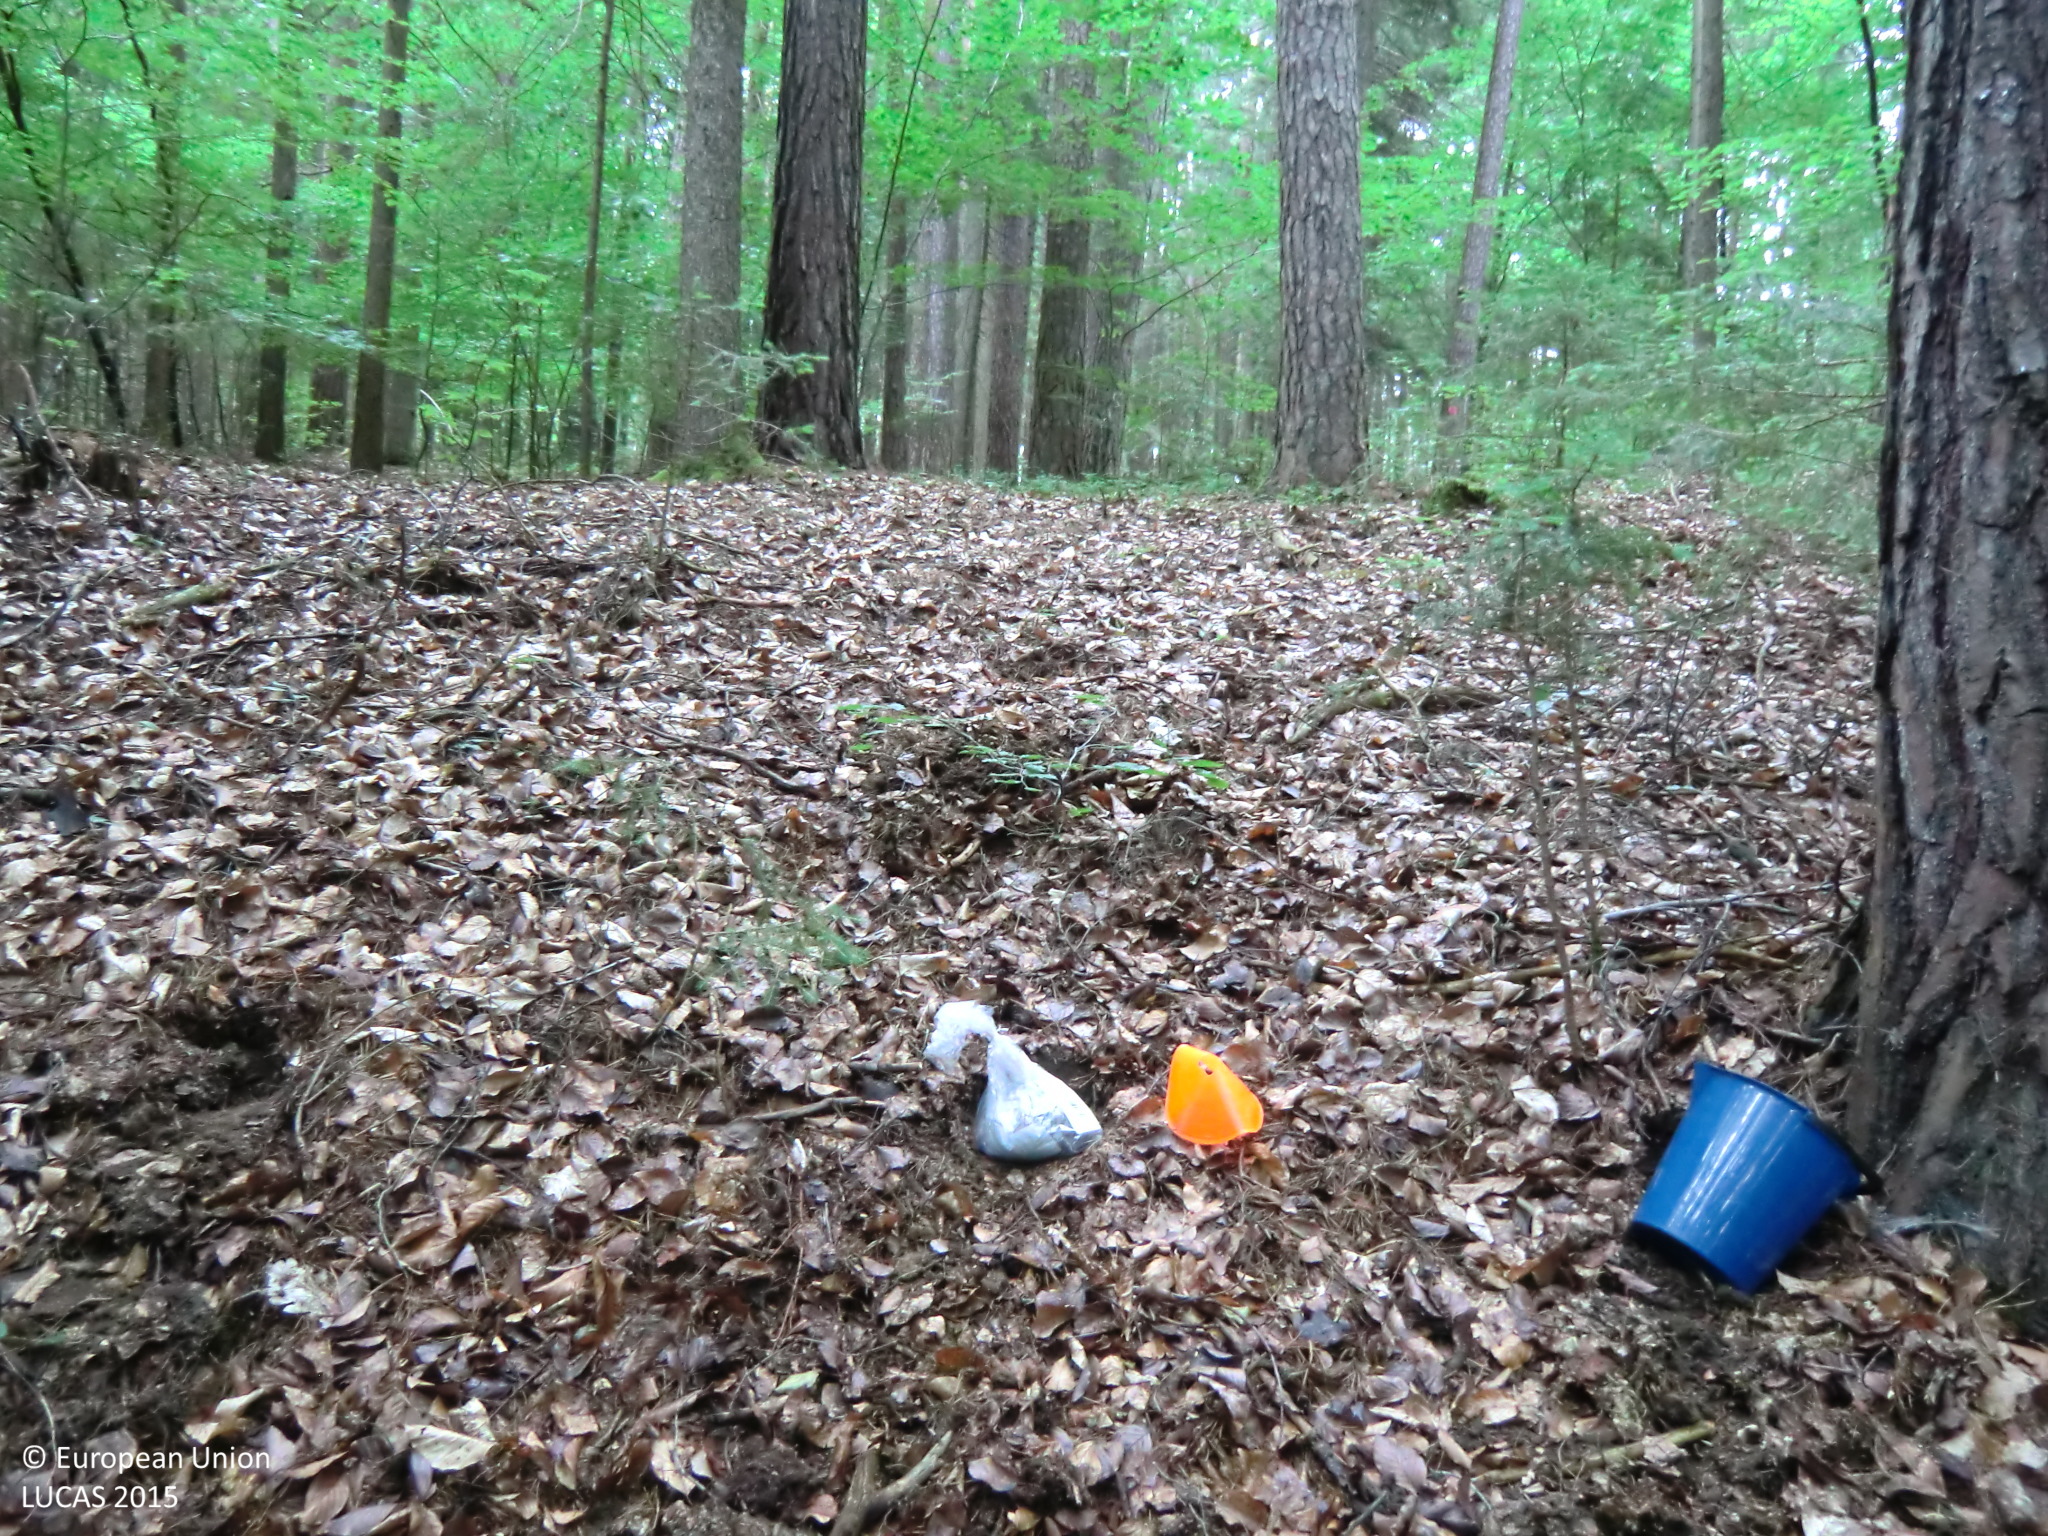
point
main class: Woodland
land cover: Pine dominated mixed woodland
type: hemiboreal forest and nemoral coniferous forest and mixed broadleaved-coniferous forest
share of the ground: > 75 %
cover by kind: coniferous forest trees 60 %, broadleaved forest trees 25 %, unconsolidated bare surface 15 %
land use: Forestry
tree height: > 5 m
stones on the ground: < 10 %
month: June
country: AT
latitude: 47.2085
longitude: 16.0616
